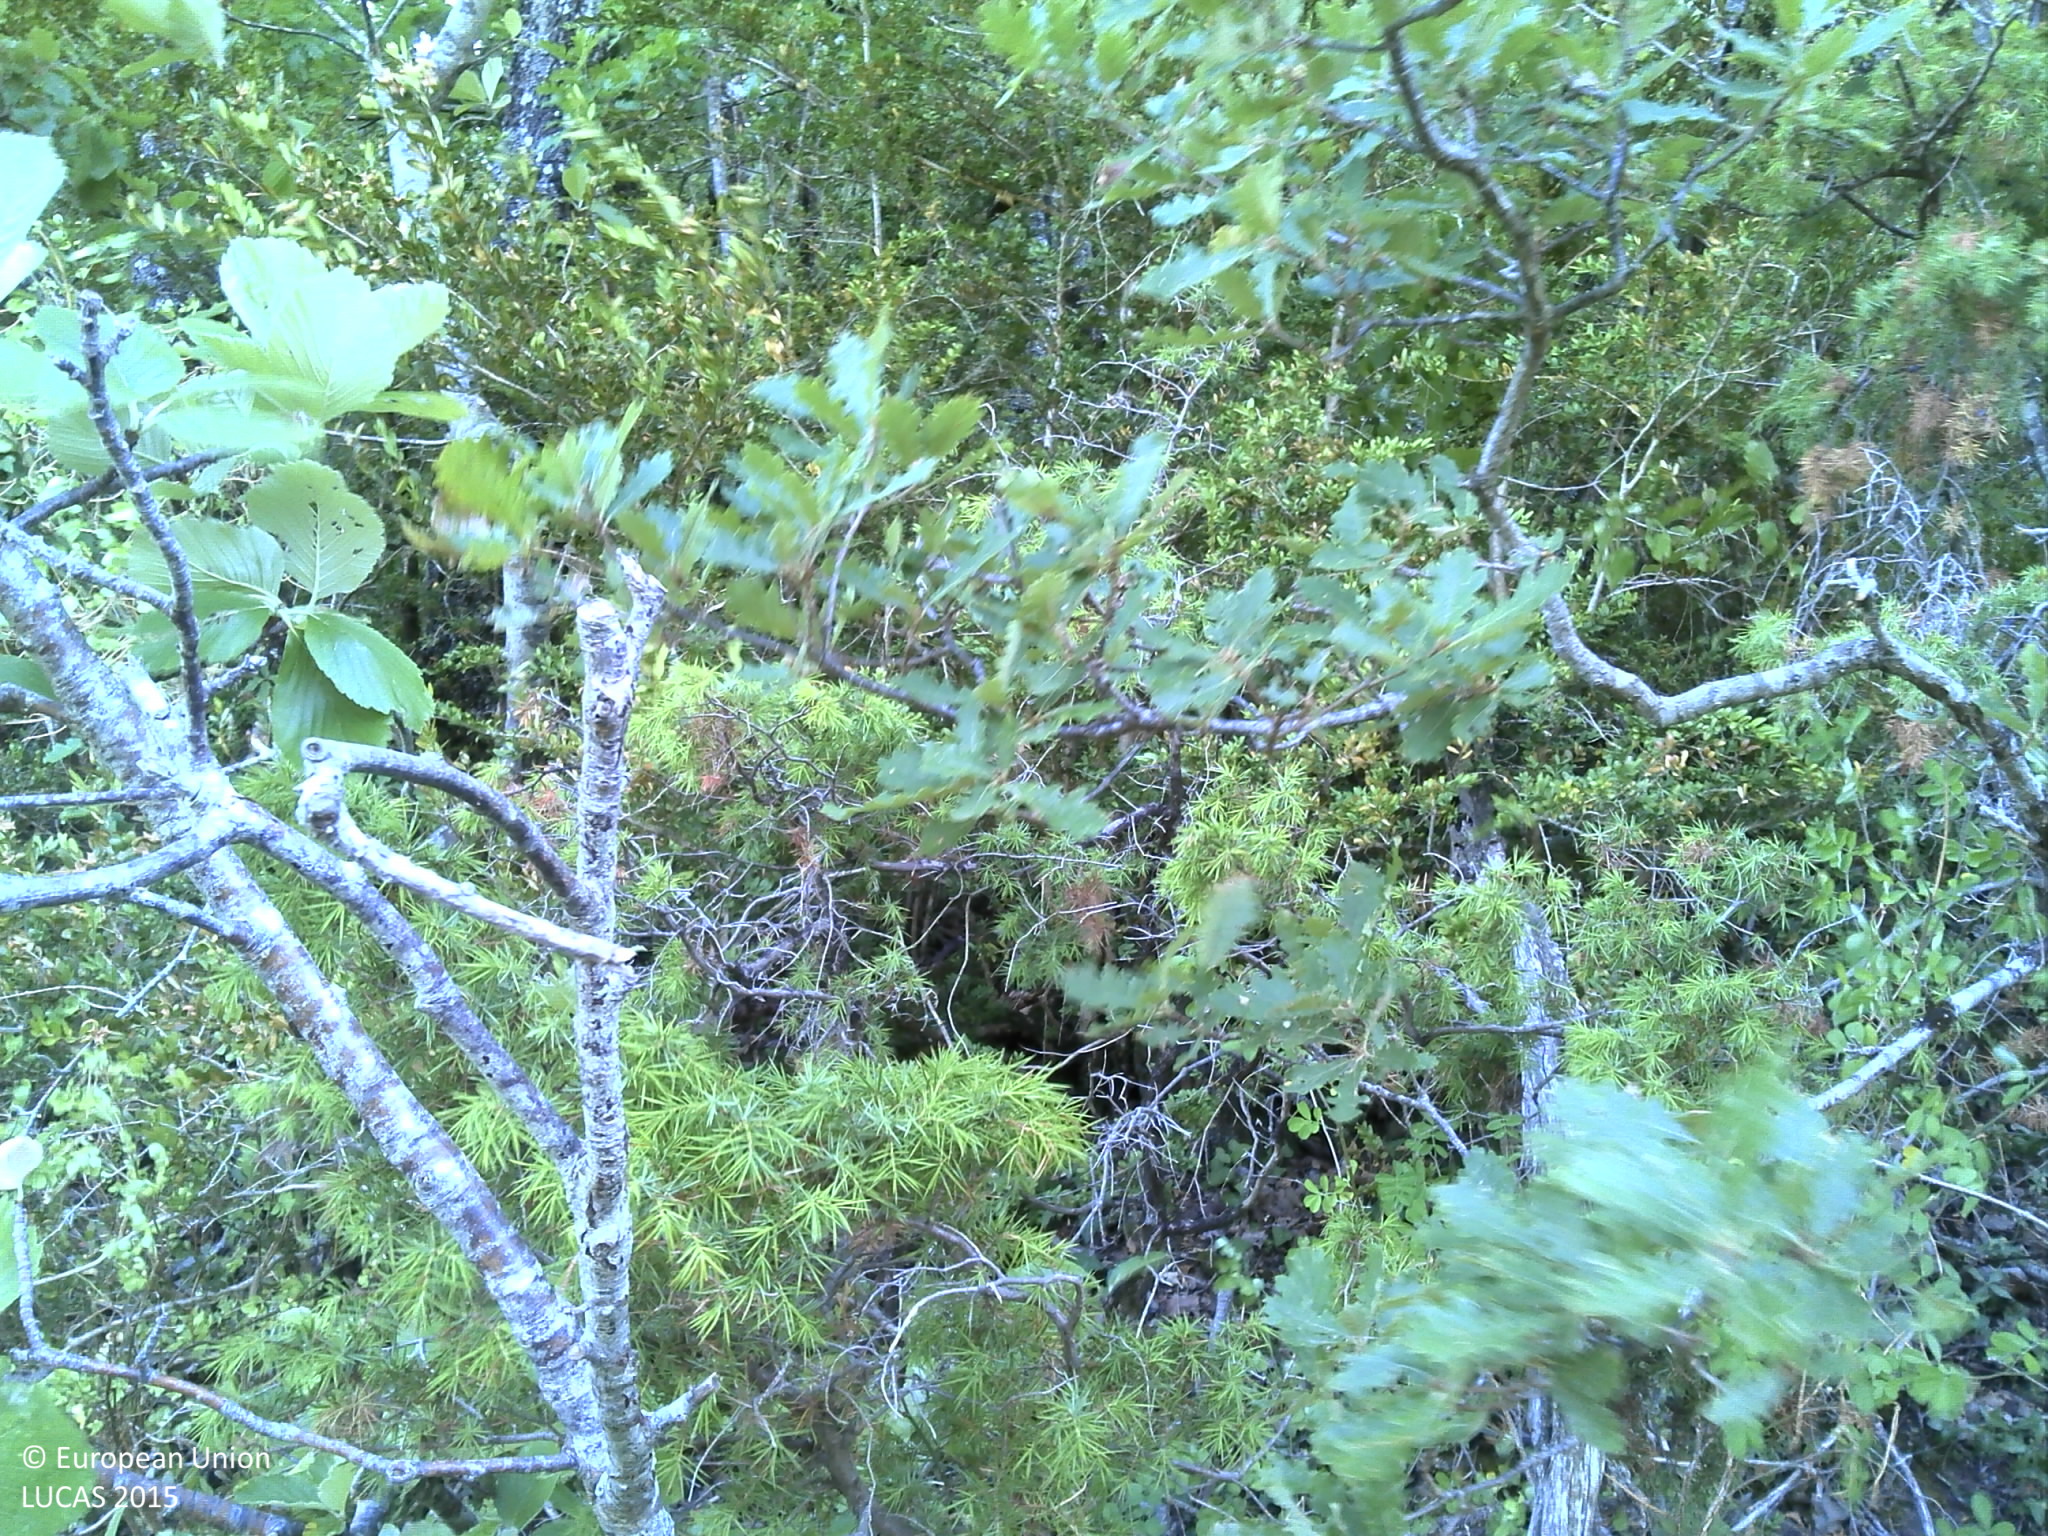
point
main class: Woodland
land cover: Broadleaved woodland
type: acidophilous oak and oak-birch forest
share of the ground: > 75 %
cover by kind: broadleaved forest trees 85 %, herbaceous plants 5 %, lichens and mosses 5 %, unconsolidated bare surface 5 %
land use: Semi-natural and natural areas not in use
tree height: > 5 m
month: July
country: FR
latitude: 43.7614
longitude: 3.1385
